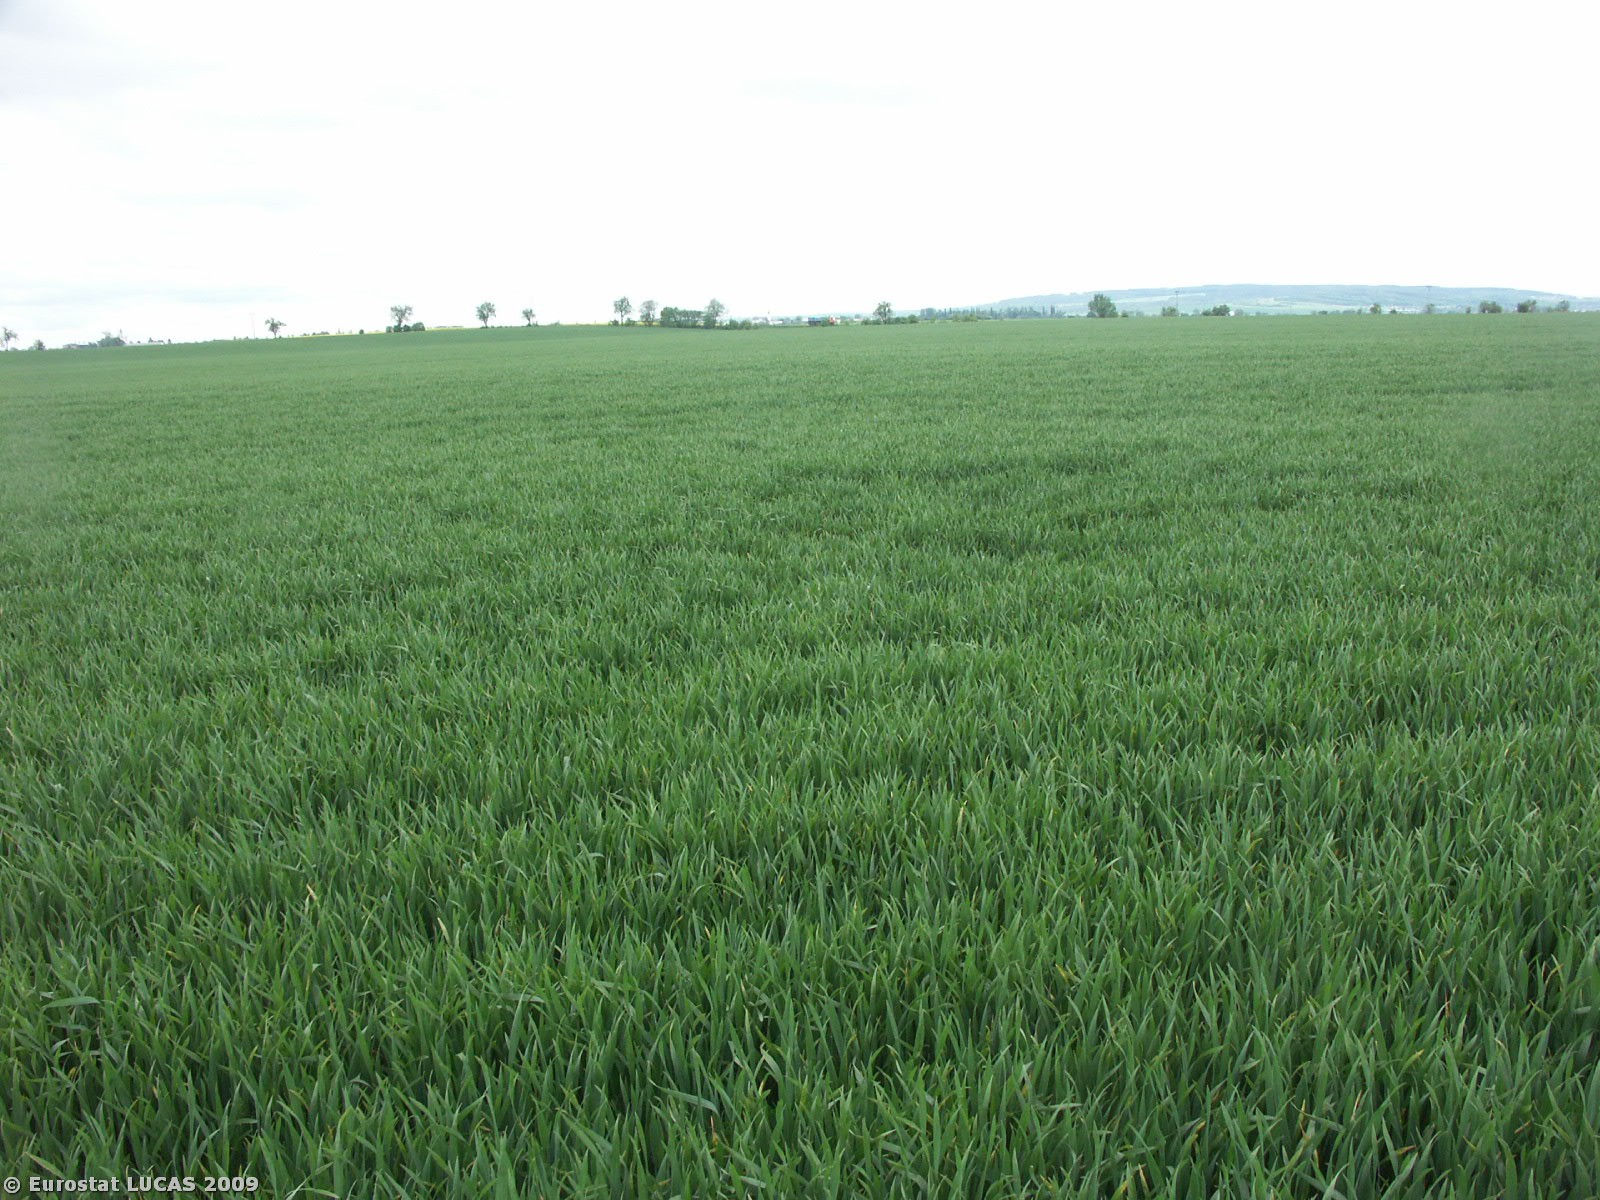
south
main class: Cropland
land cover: Common wheat
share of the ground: > 75 %
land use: Agriculture (excluding fallow land and kitchen gardens)
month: May
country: CZ
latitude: 49.6174
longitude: 17.1384
